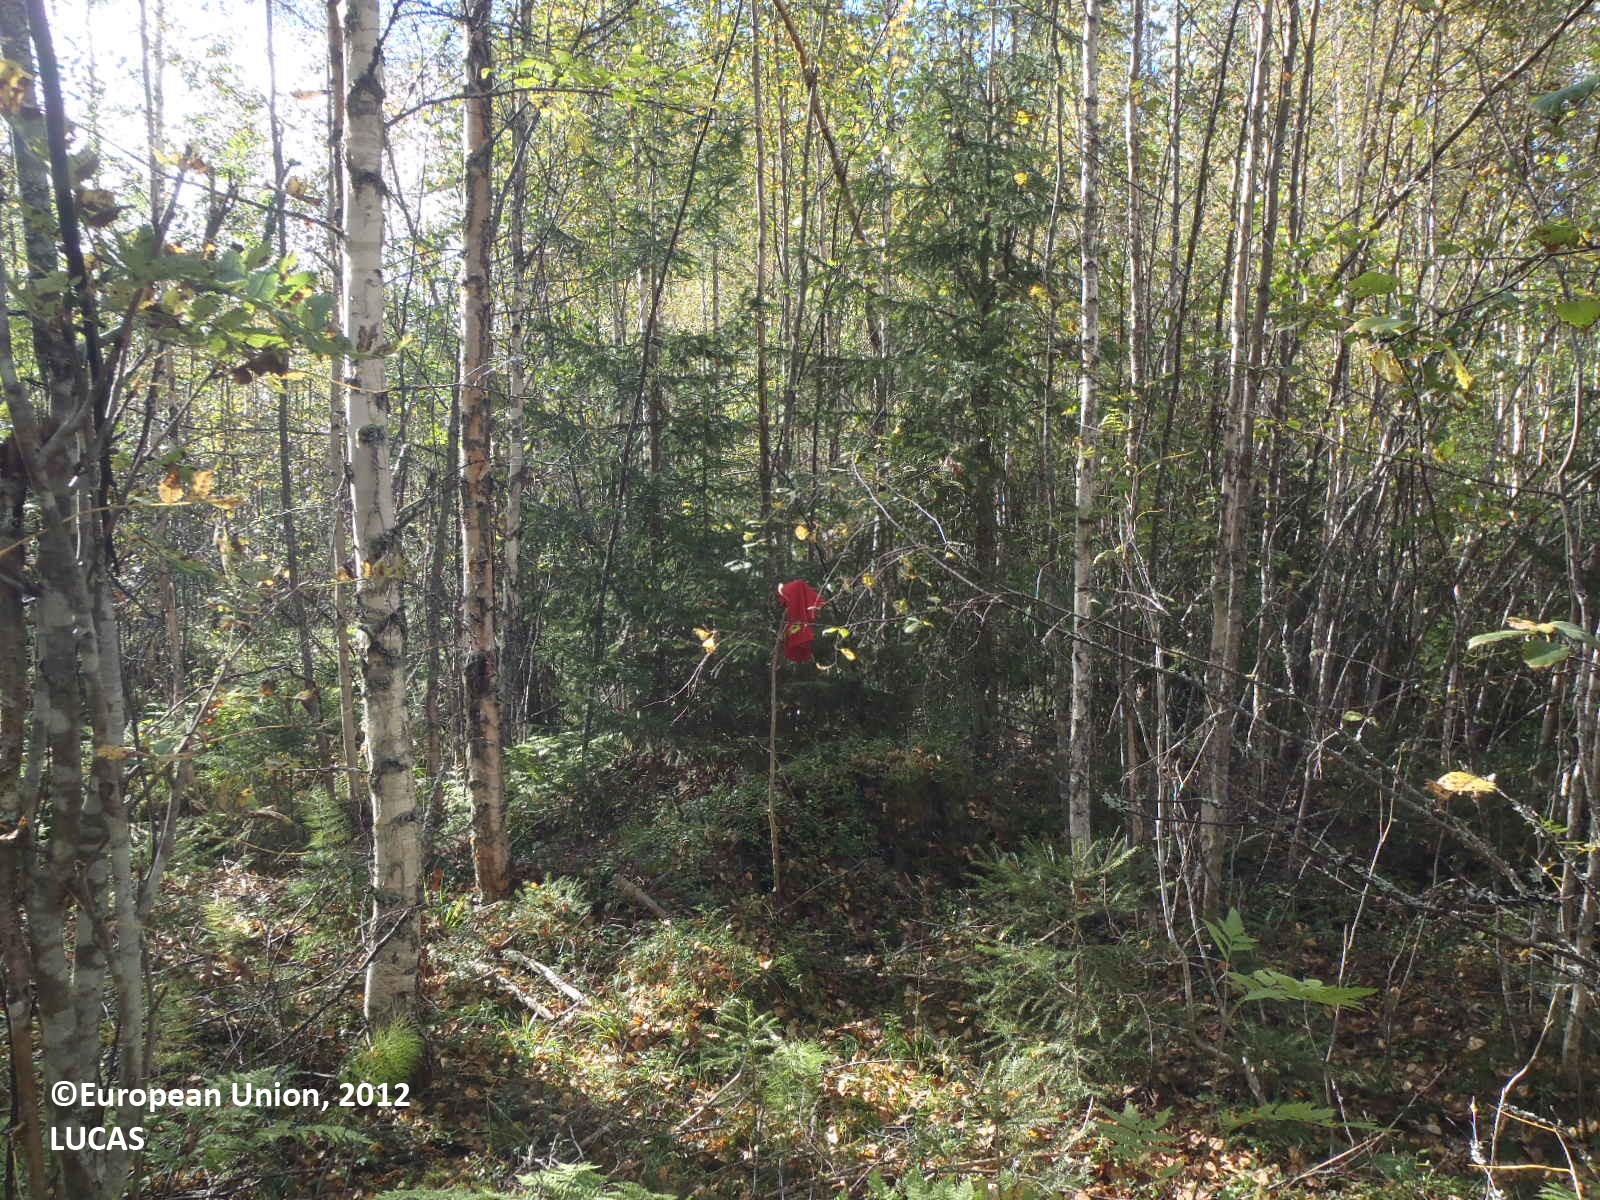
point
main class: Woodland
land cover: Broadleaved woodland
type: boreal forest
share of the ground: > 75 %
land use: Forestry
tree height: > 5 m
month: September
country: FI
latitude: 61.5166
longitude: 22.5641
